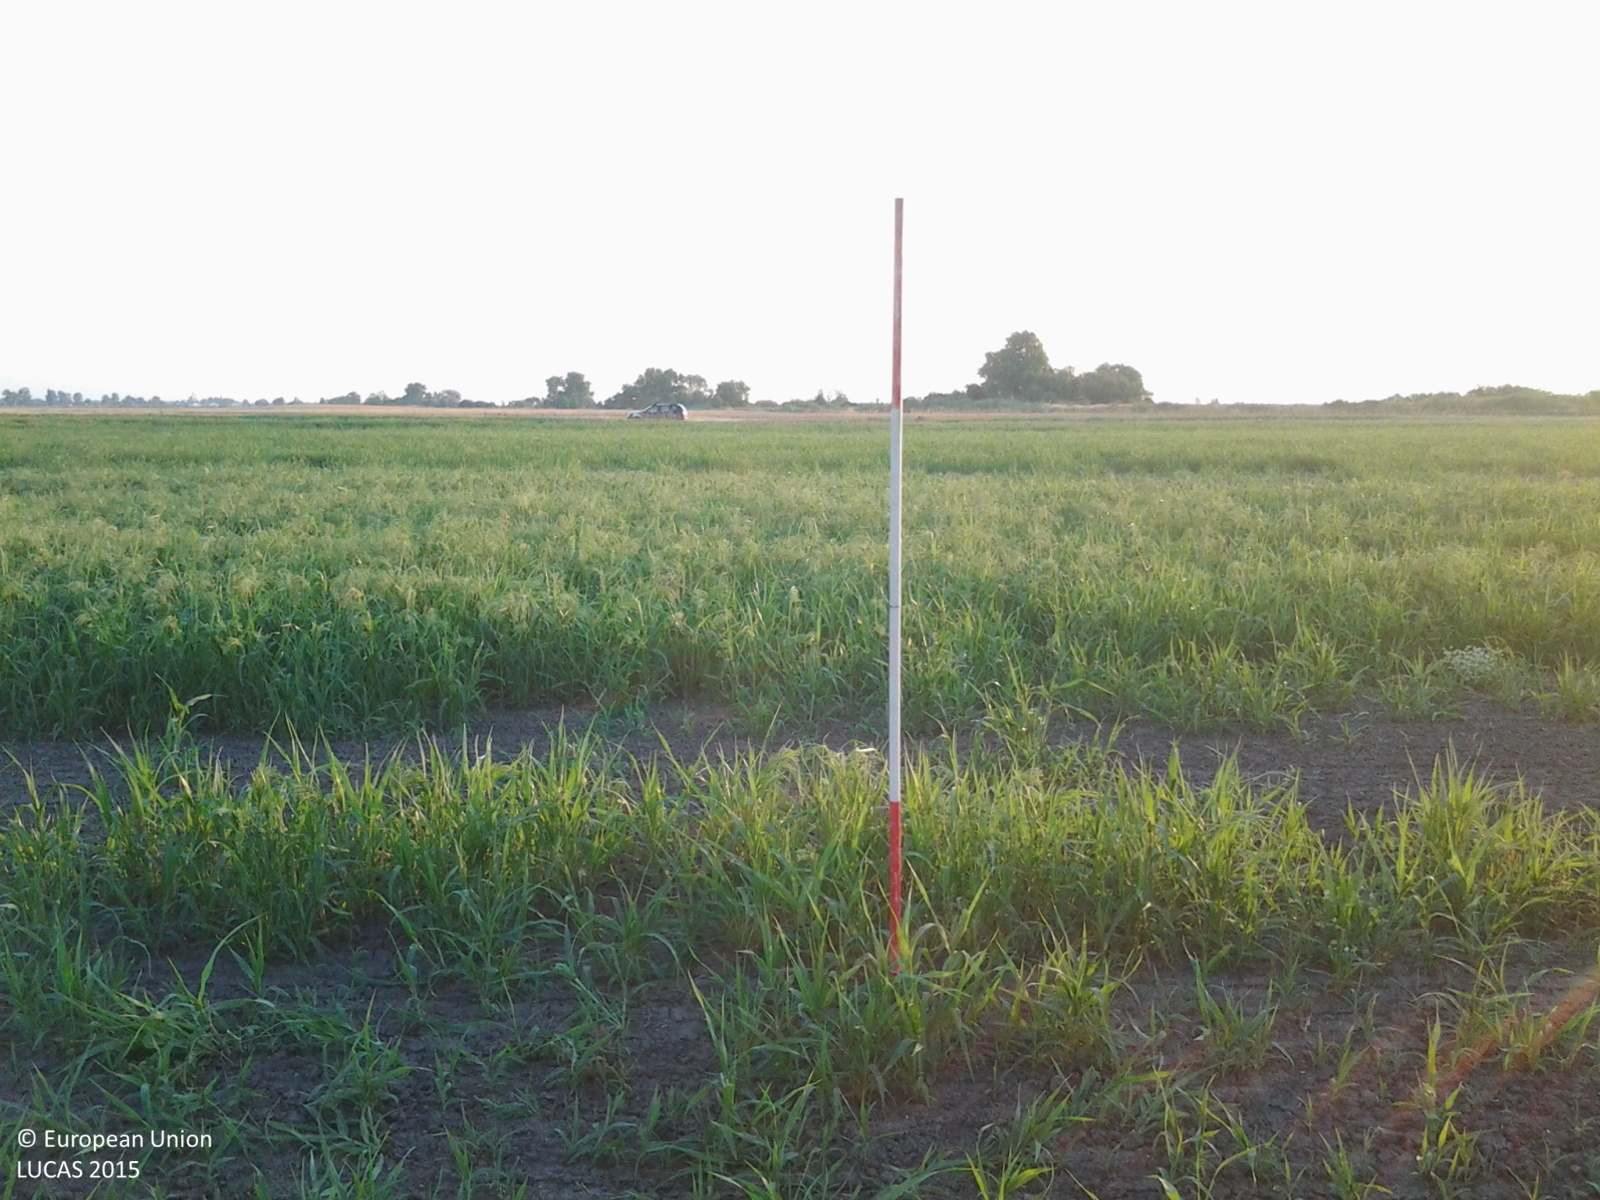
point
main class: Cropland
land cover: Other cereals
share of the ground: 50 - 75 %
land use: Agriculture (excluding fallow land and kitchen gardens)
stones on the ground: < 10 %
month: July
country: HU
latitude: 47.1151
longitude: 20.9335
